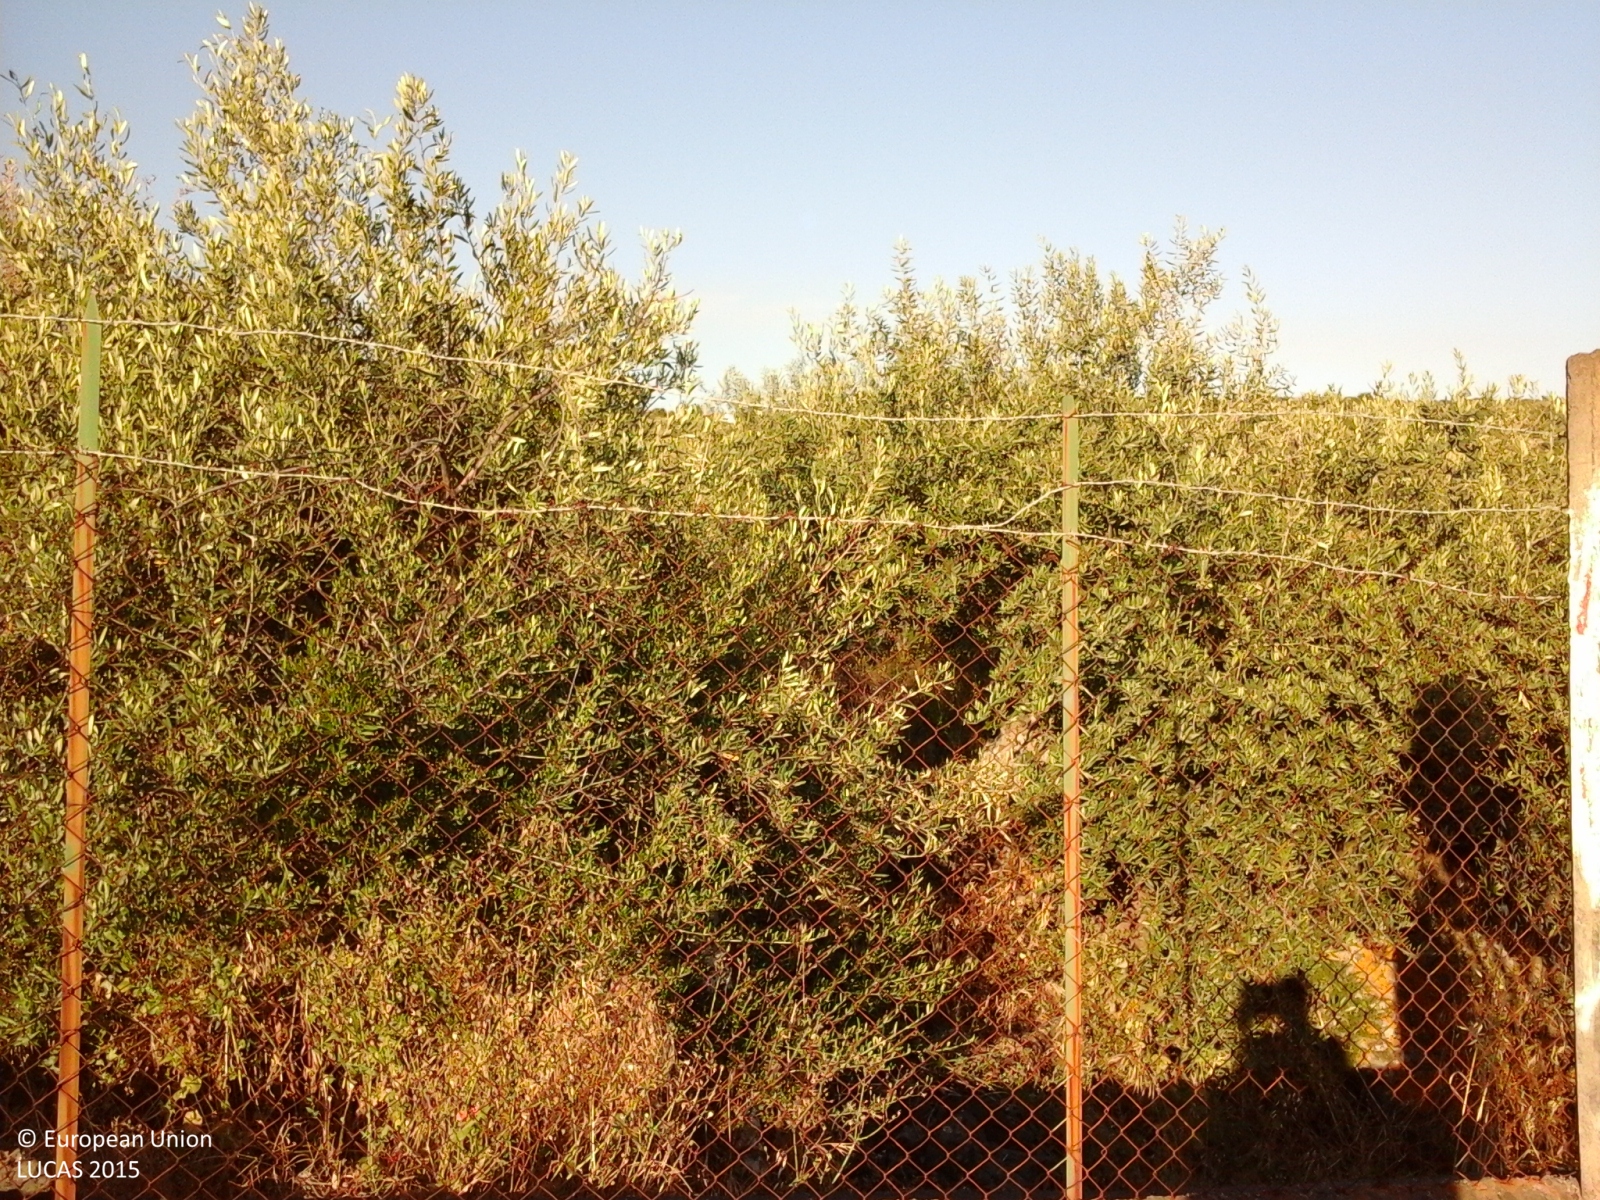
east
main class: Cropland
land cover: Other citrus fruit
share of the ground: 25 - 50 %
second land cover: Spontaneously vegetated surfaces
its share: 10 - 25 %
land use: Agriculture (excluding fallow land and kitchen gardens)
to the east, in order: Other citrus fruit; Spontaneously vegetated surfaces; Artificial constructions; Permanent crops (only in case pi); Artificial constructions in urban areas; Permanent crops (only in case pi); Electric lines; Permanent crops (only in case pi); Arable land (only in case pi); Permanent crops (only in case pi); Artificial constructions in urban areas
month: May
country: IT
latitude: 37.6974
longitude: 14.8315
